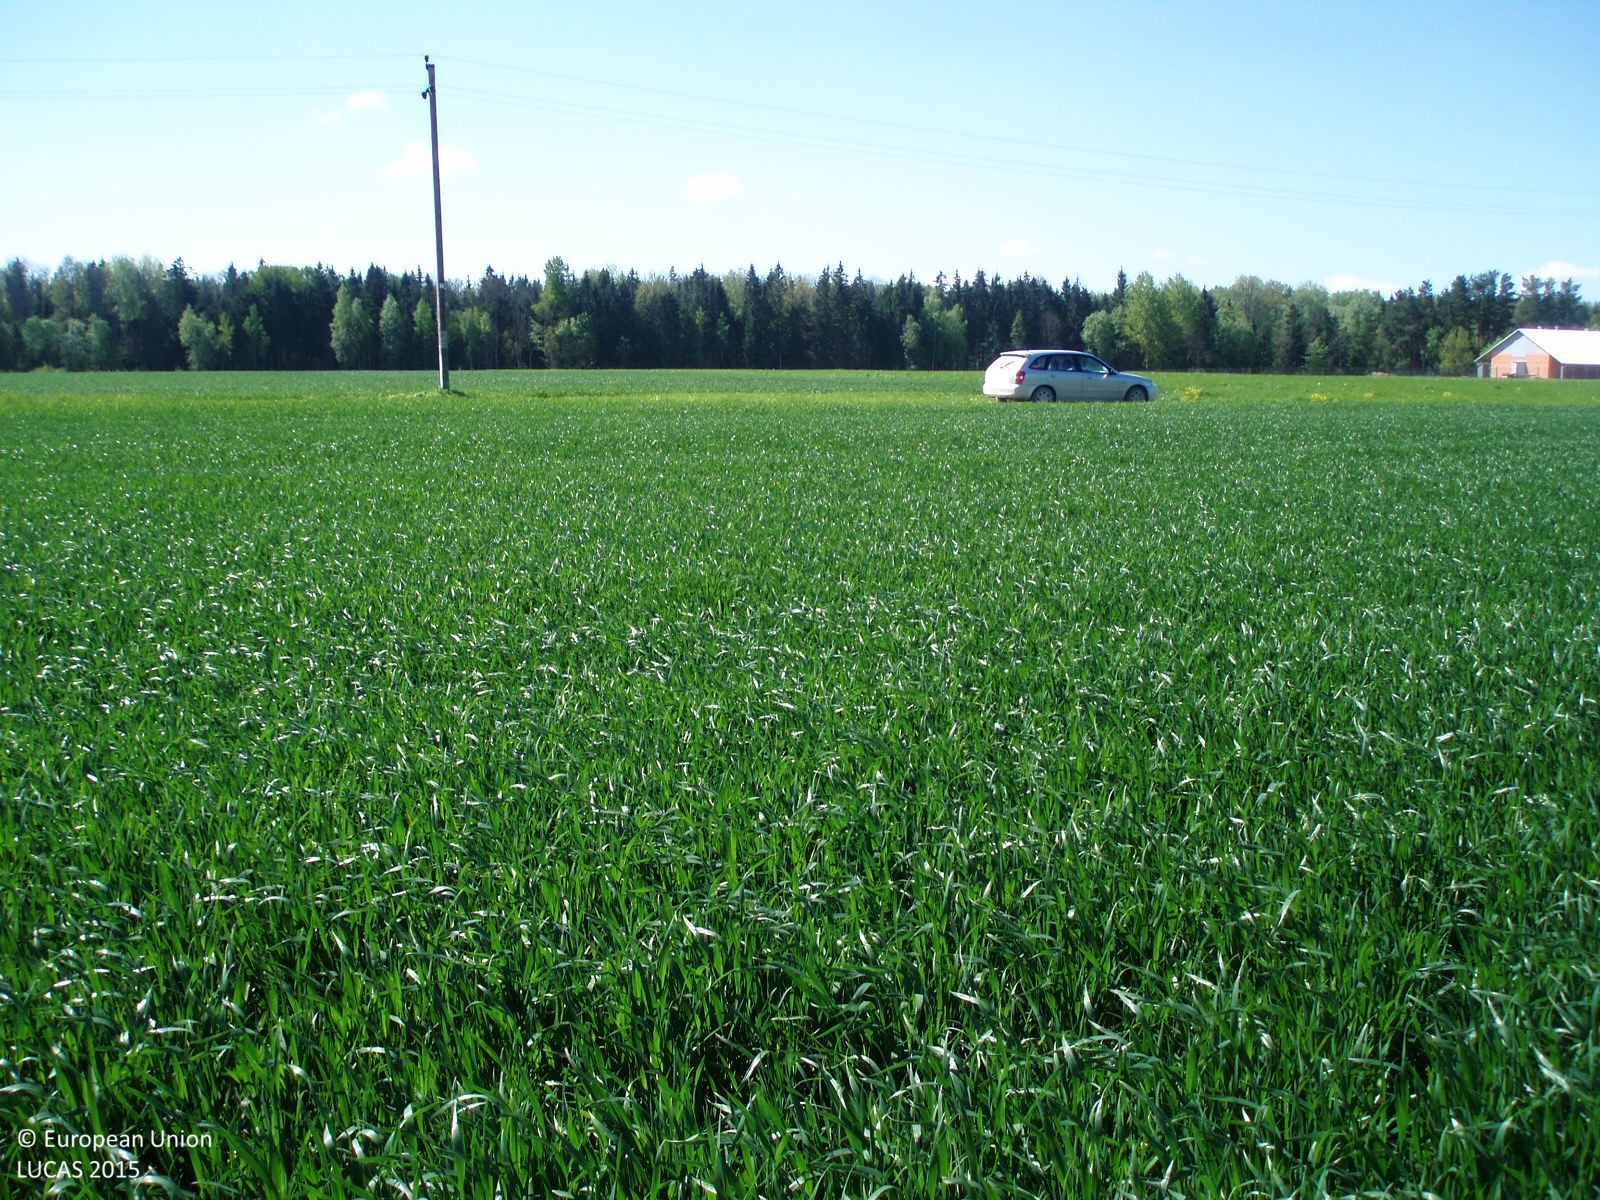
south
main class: Cropland
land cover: Barley
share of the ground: > 75 %
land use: Agriculture (excluding fallow land and kitchen gardens)
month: May
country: LT
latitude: 56.3441
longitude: 22.6311
